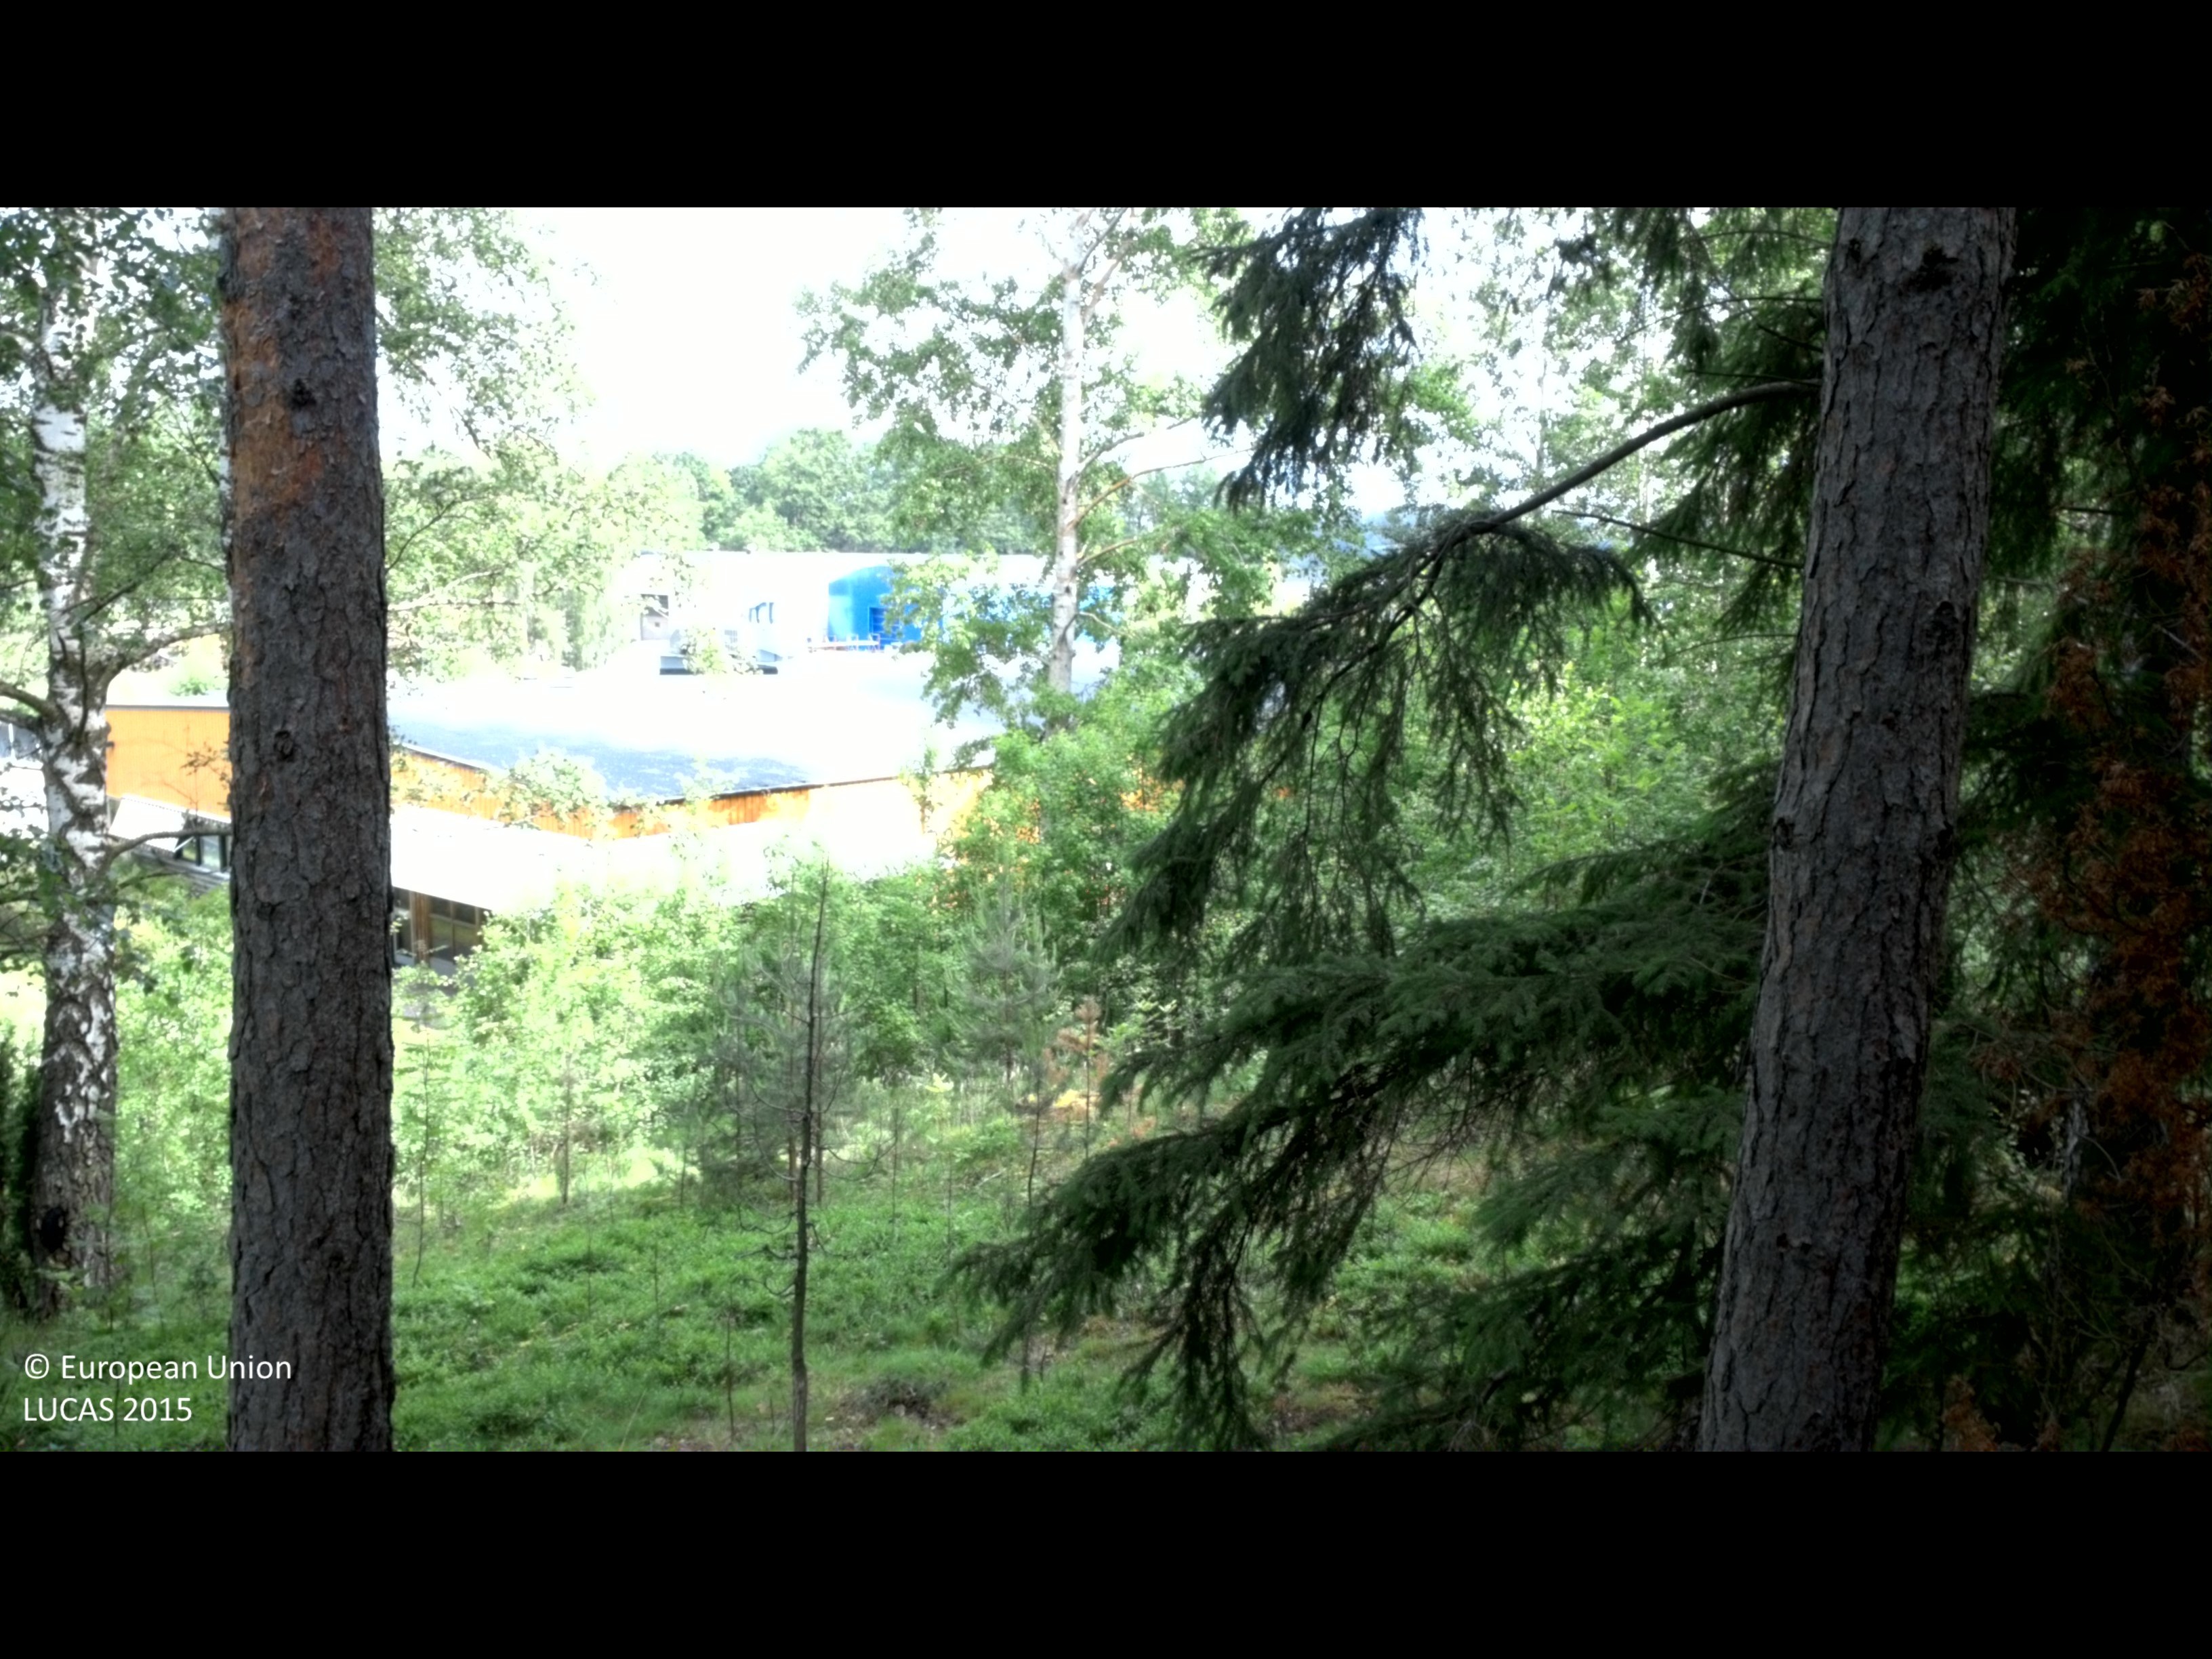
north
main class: Woodland
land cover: Other coniferous woodland
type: boreal forest
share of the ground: 50 - 75 %
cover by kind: coniferous forest trees 60 %, broadleaved forest trees 10 %, shrubs 10 %, herbaceous plants 10 %, lichens and mosses 10 %
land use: Forestry
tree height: > 5 m
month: June
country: SE
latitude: 57.8871
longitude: 16.3900
